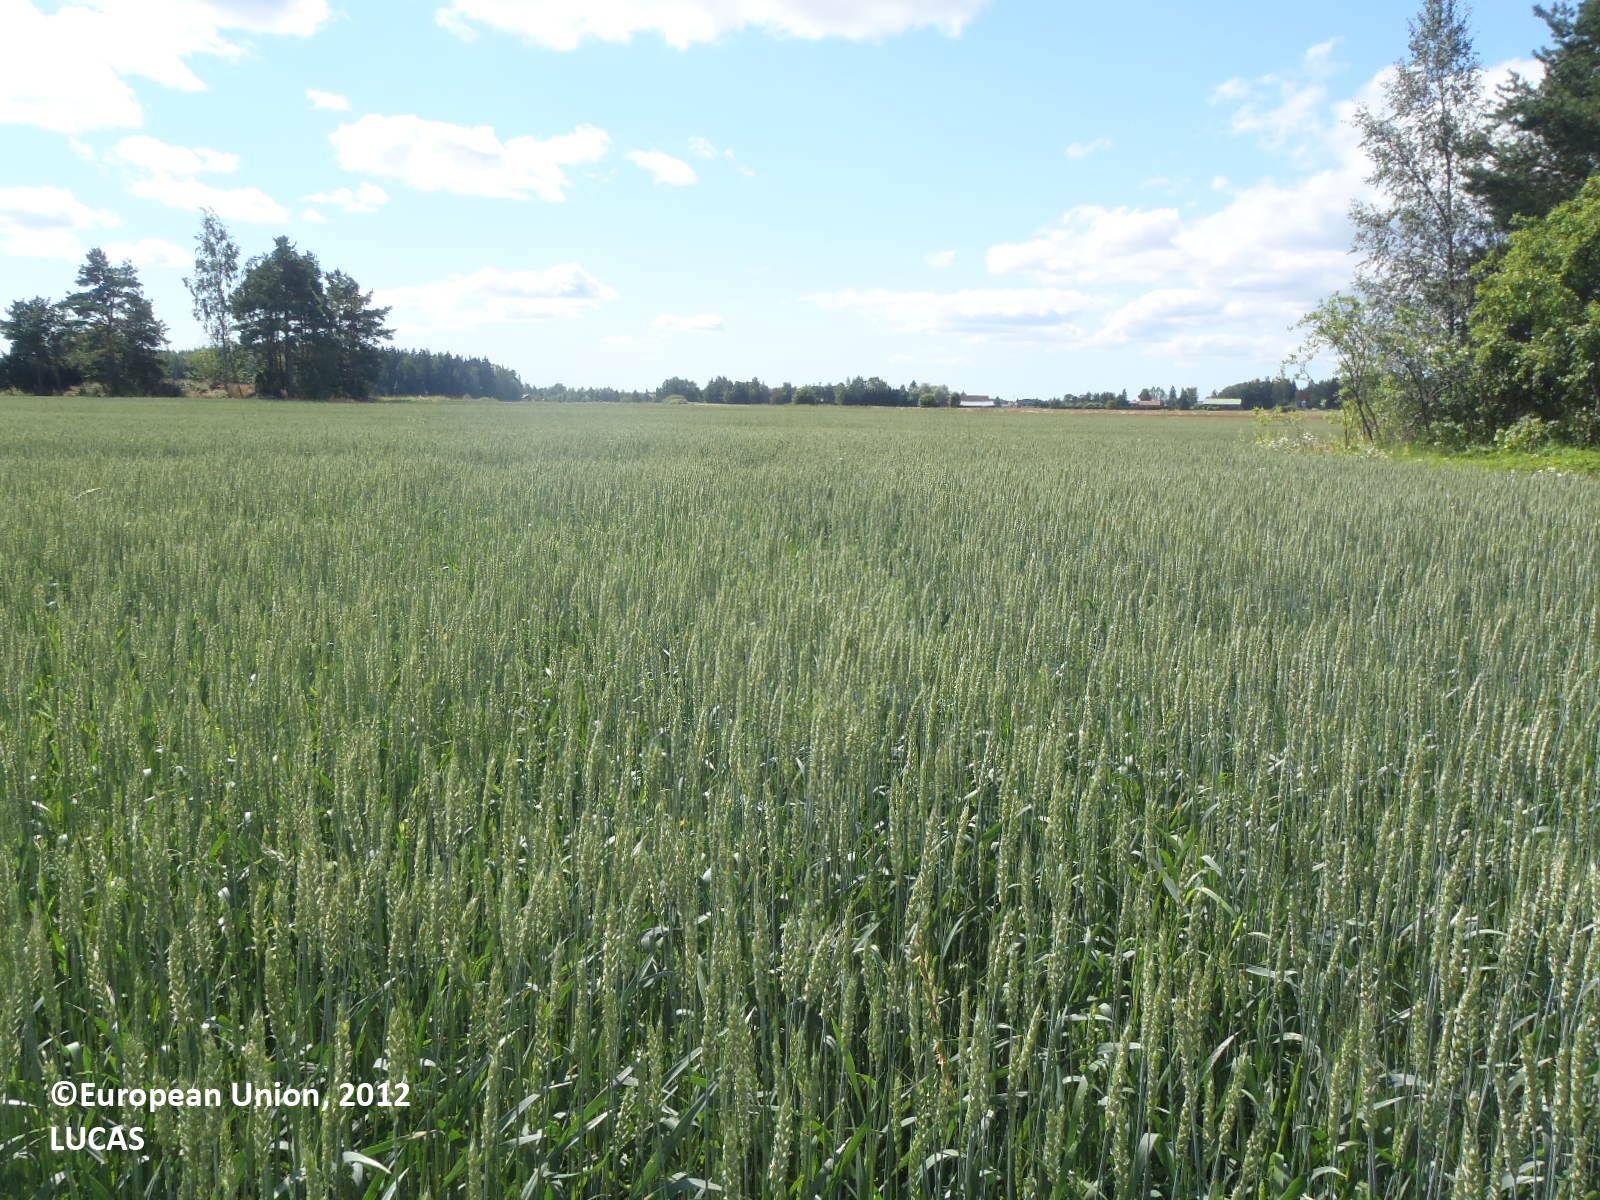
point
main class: Cropland
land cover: Common wheat
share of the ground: > 75 %
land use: Agriculture (excluding fallow land and kitchen gardens)
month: July
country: FI
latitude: 60.6392
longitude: 21.9276
